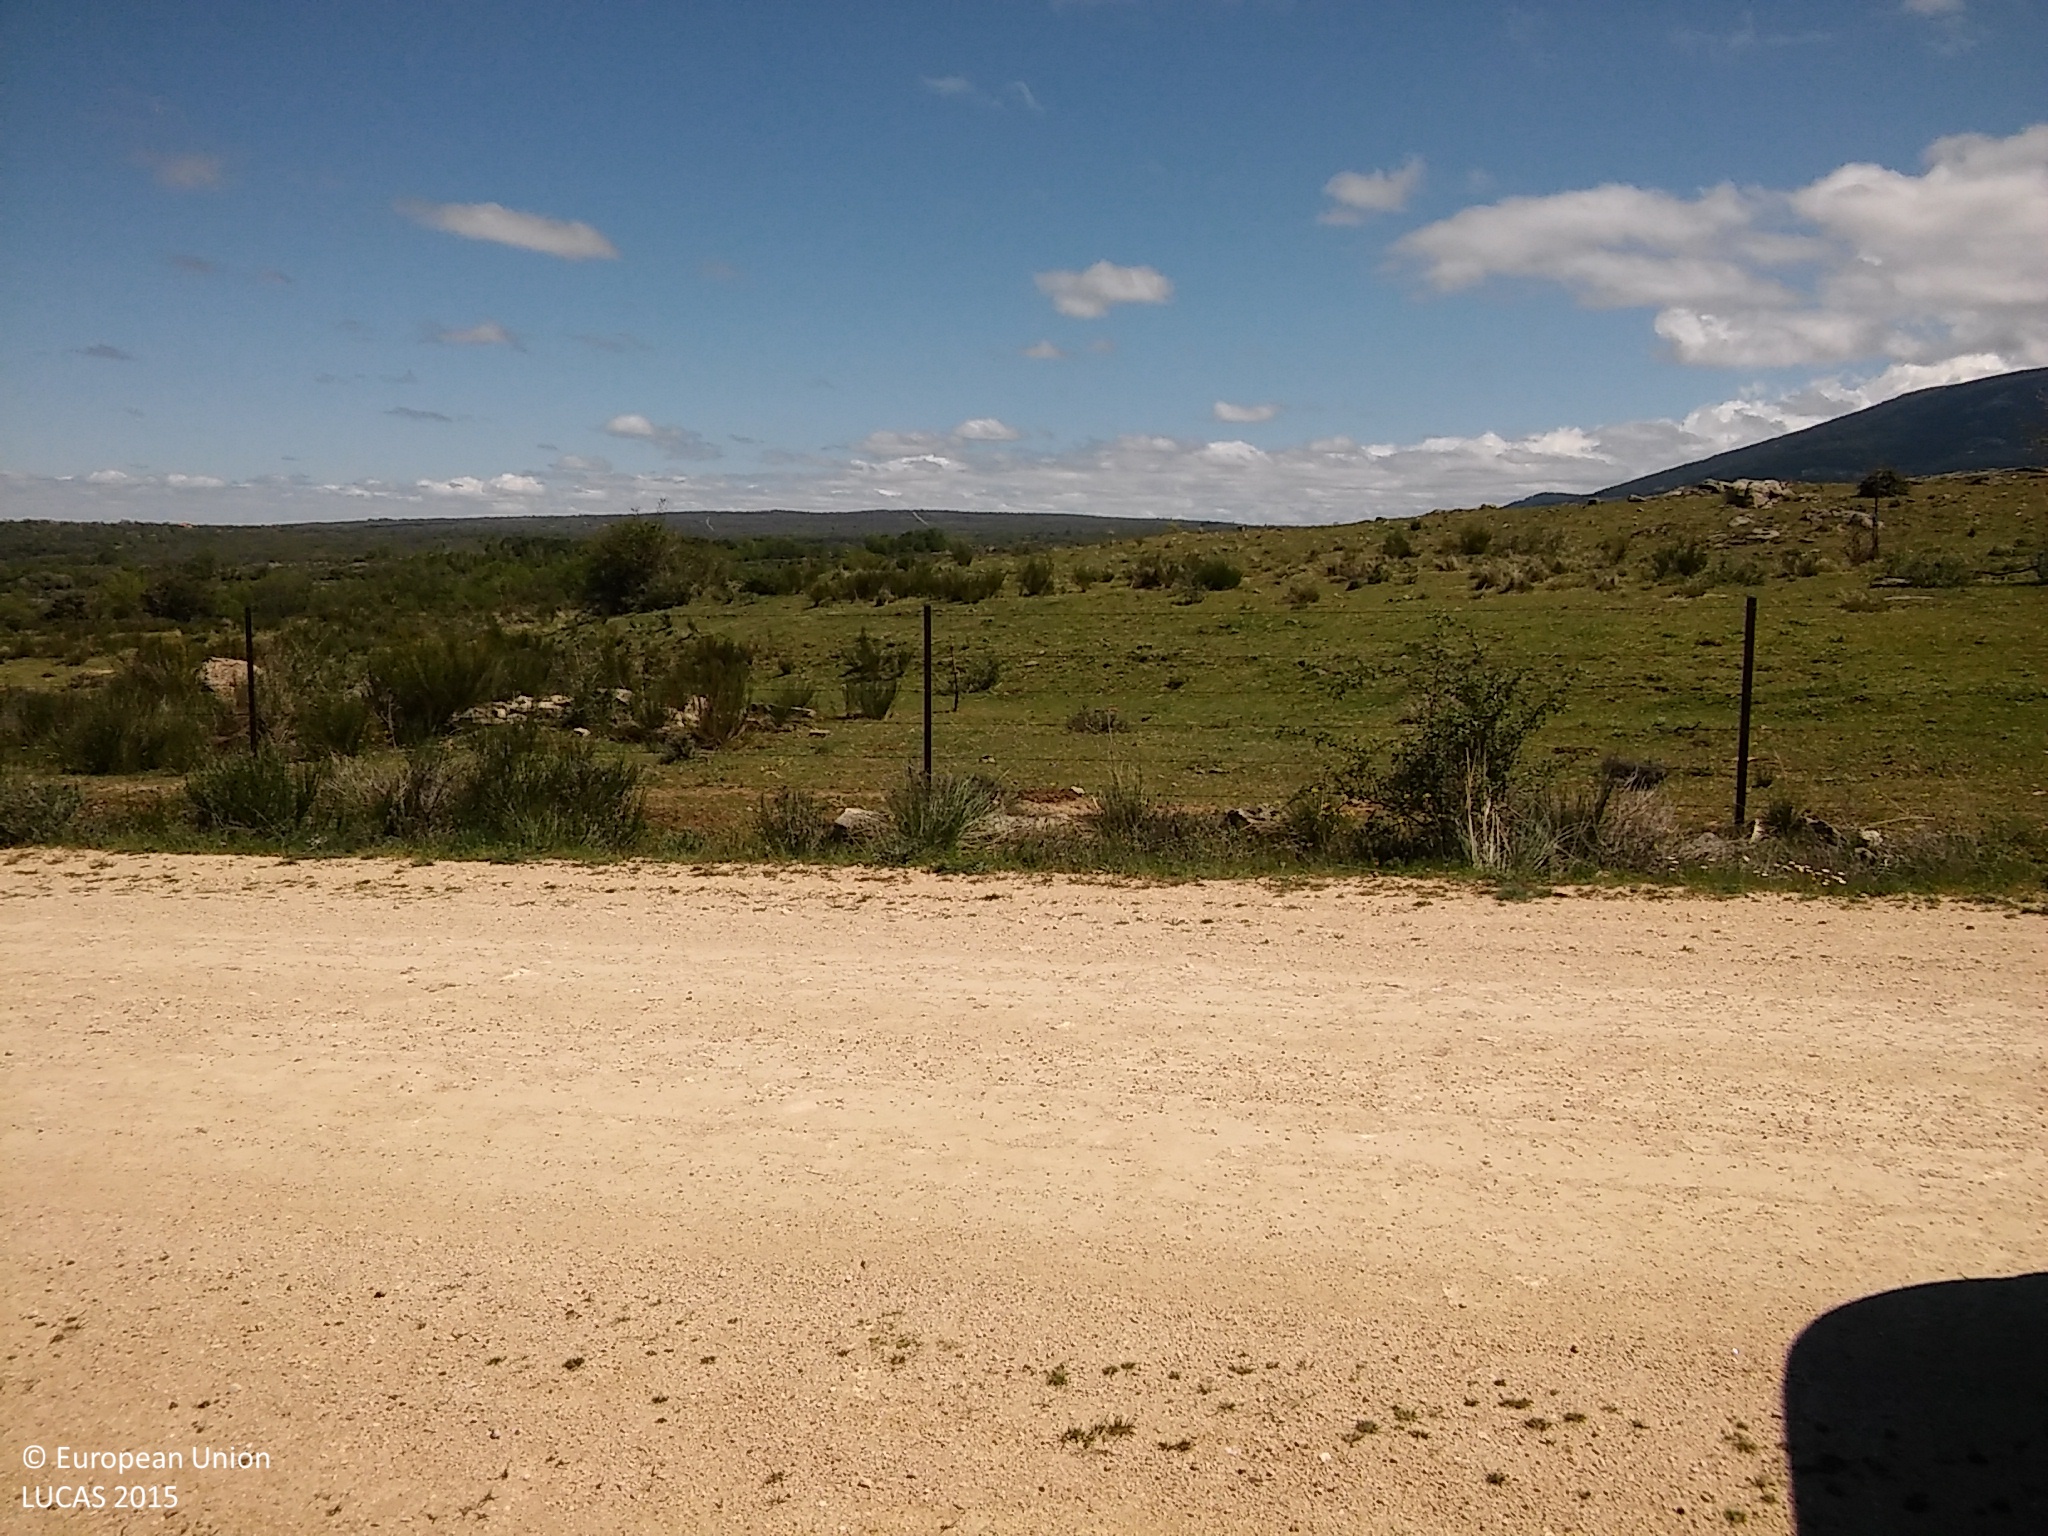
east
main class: Grassland
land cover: Grassland without tree/shrub cover
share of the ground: > 75 %
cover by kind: herbaceous plants 95 %, consolidated bare surface 5 %
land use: Agriculture (excluding fallow land and kitchen gardens)
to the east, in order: Grassland without tree/shrub cover; Grassland with sparse tree/shrub cover; Grassland without tree/shrub cover; Dry stone walls; Single bushes/trees; Grassland with sparse tree/shrub cover; Dry stone walls; Grassland with sparse tree/shrub cover; Fences; Grass margins; Tracks; Grassland without tree/shrub cover; Fences; Grassland without tree/shrub cover; Rock outcrops; Grassland without tree/shrub cover
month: May
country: ES
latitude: 41.0207
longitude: -3.9749
